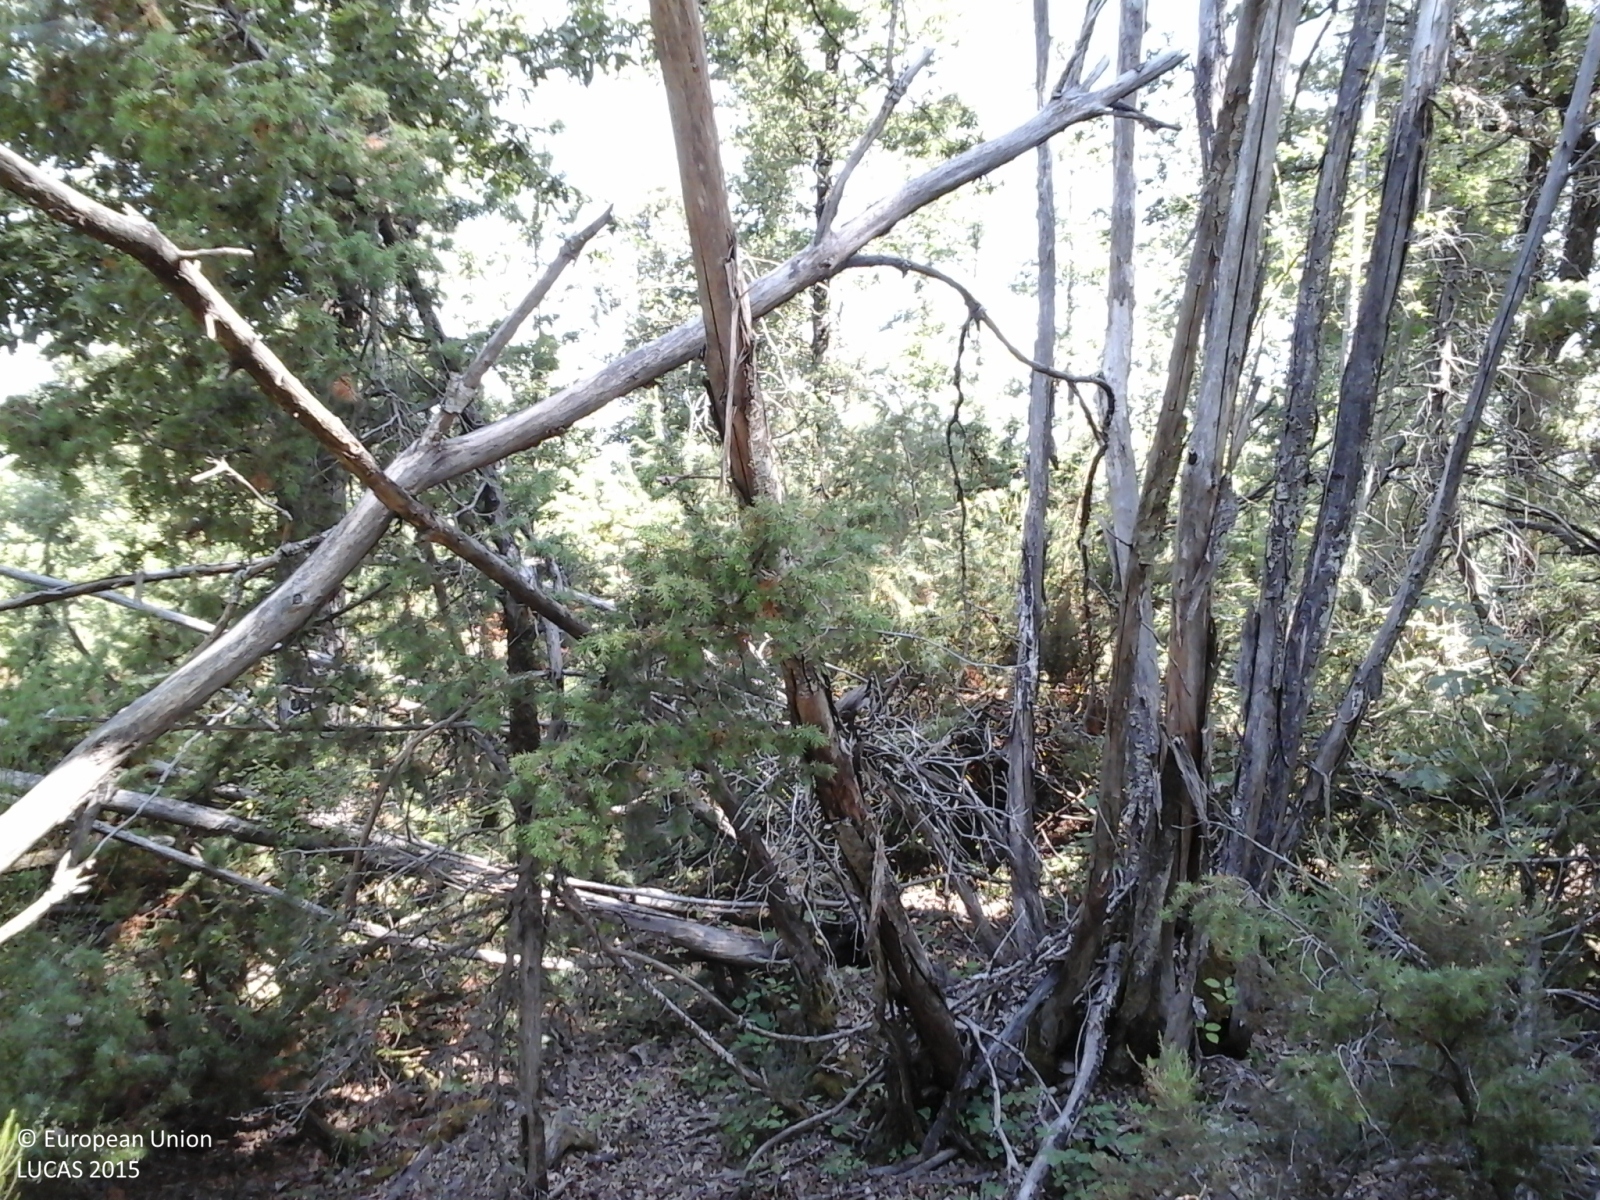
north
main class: Woodland
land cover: Broadleaved woodland
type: thermophilous deciduous forest
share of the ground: 50 - 75 %
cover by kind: shrubs 50 %, broadleaved forest trees 40 %, herbaceous plants 10 %
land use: Forestry
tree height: > 5 m
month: July
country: IT
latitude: 43.0630
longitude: 11.1385
